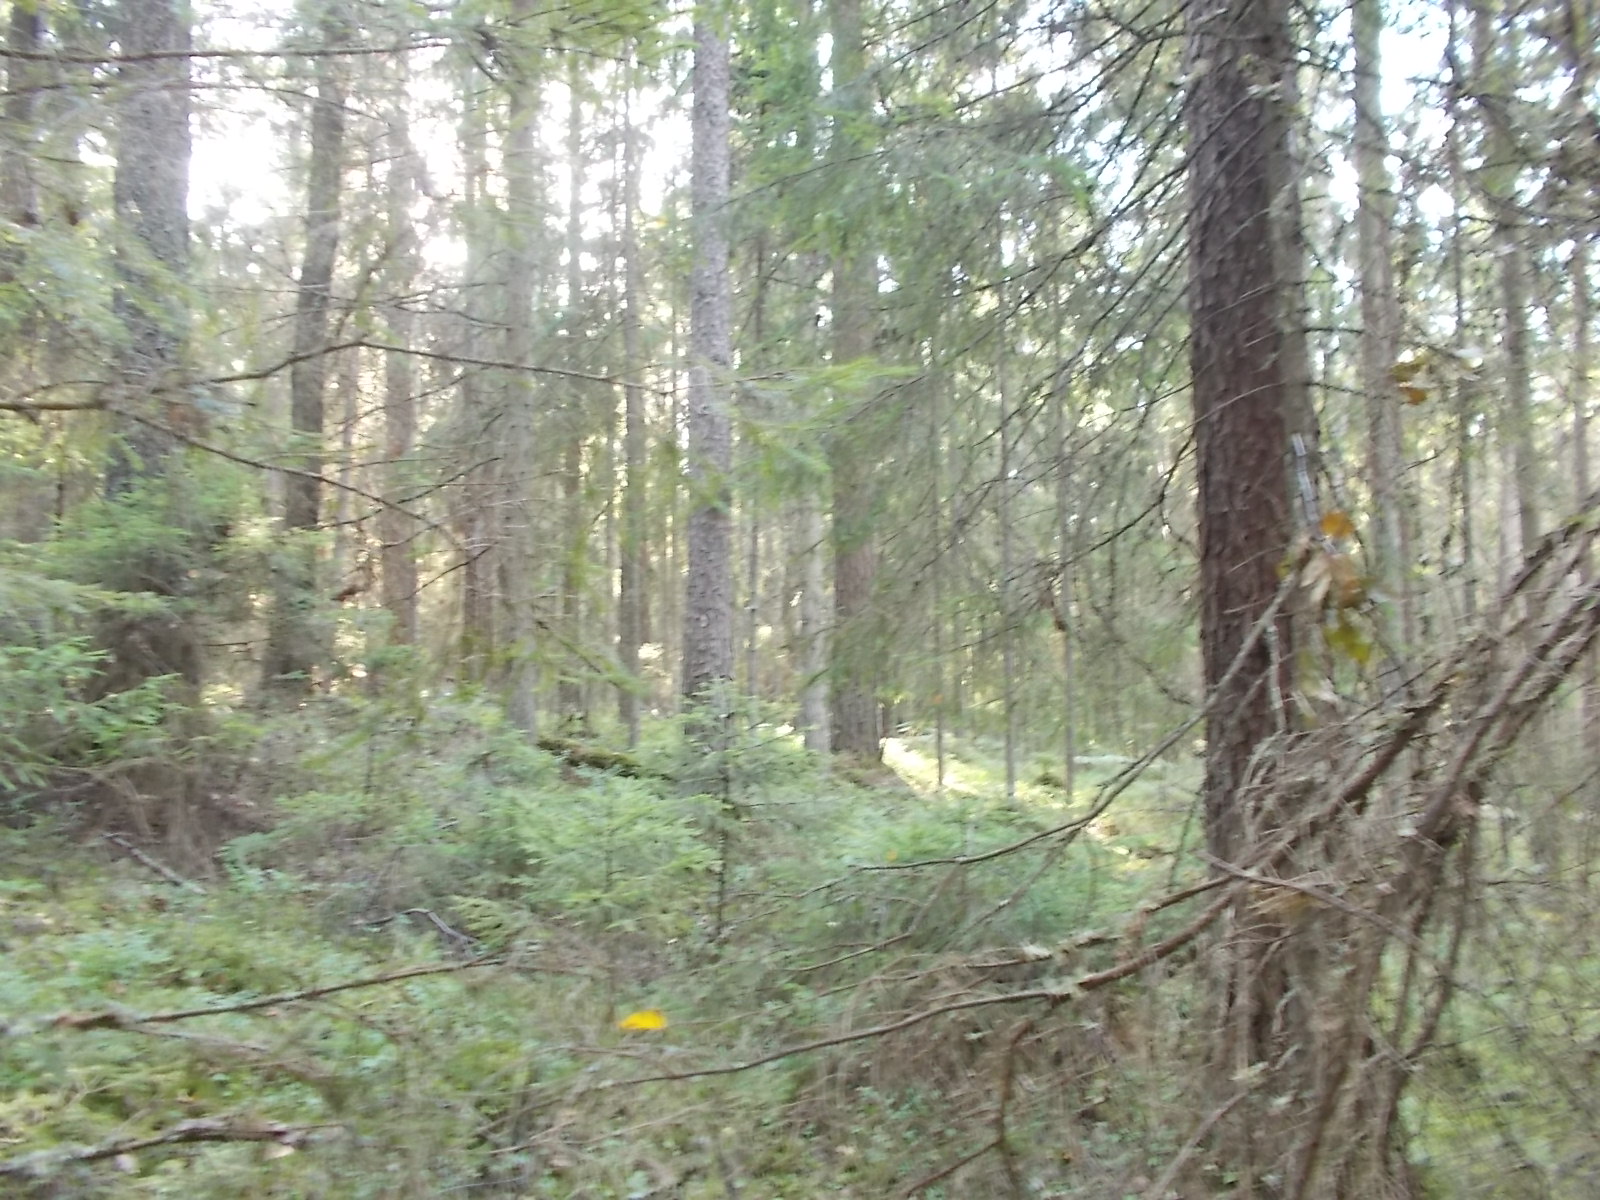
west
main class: Woodland
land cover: Other coniferous woodland
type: hemiboreal forest and nemoral coniferous forest and mixed broadleaved-coniferous forest
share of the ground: 50 - 75 %
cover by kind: coniferous forest trees 70 %, broadleaved forest trees 10 %, shrubs 10 %, herbaceous plants 10 %
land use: Forestry
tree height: > 5 m
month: August
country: LV
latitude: 57.1016
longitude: 21.7472
